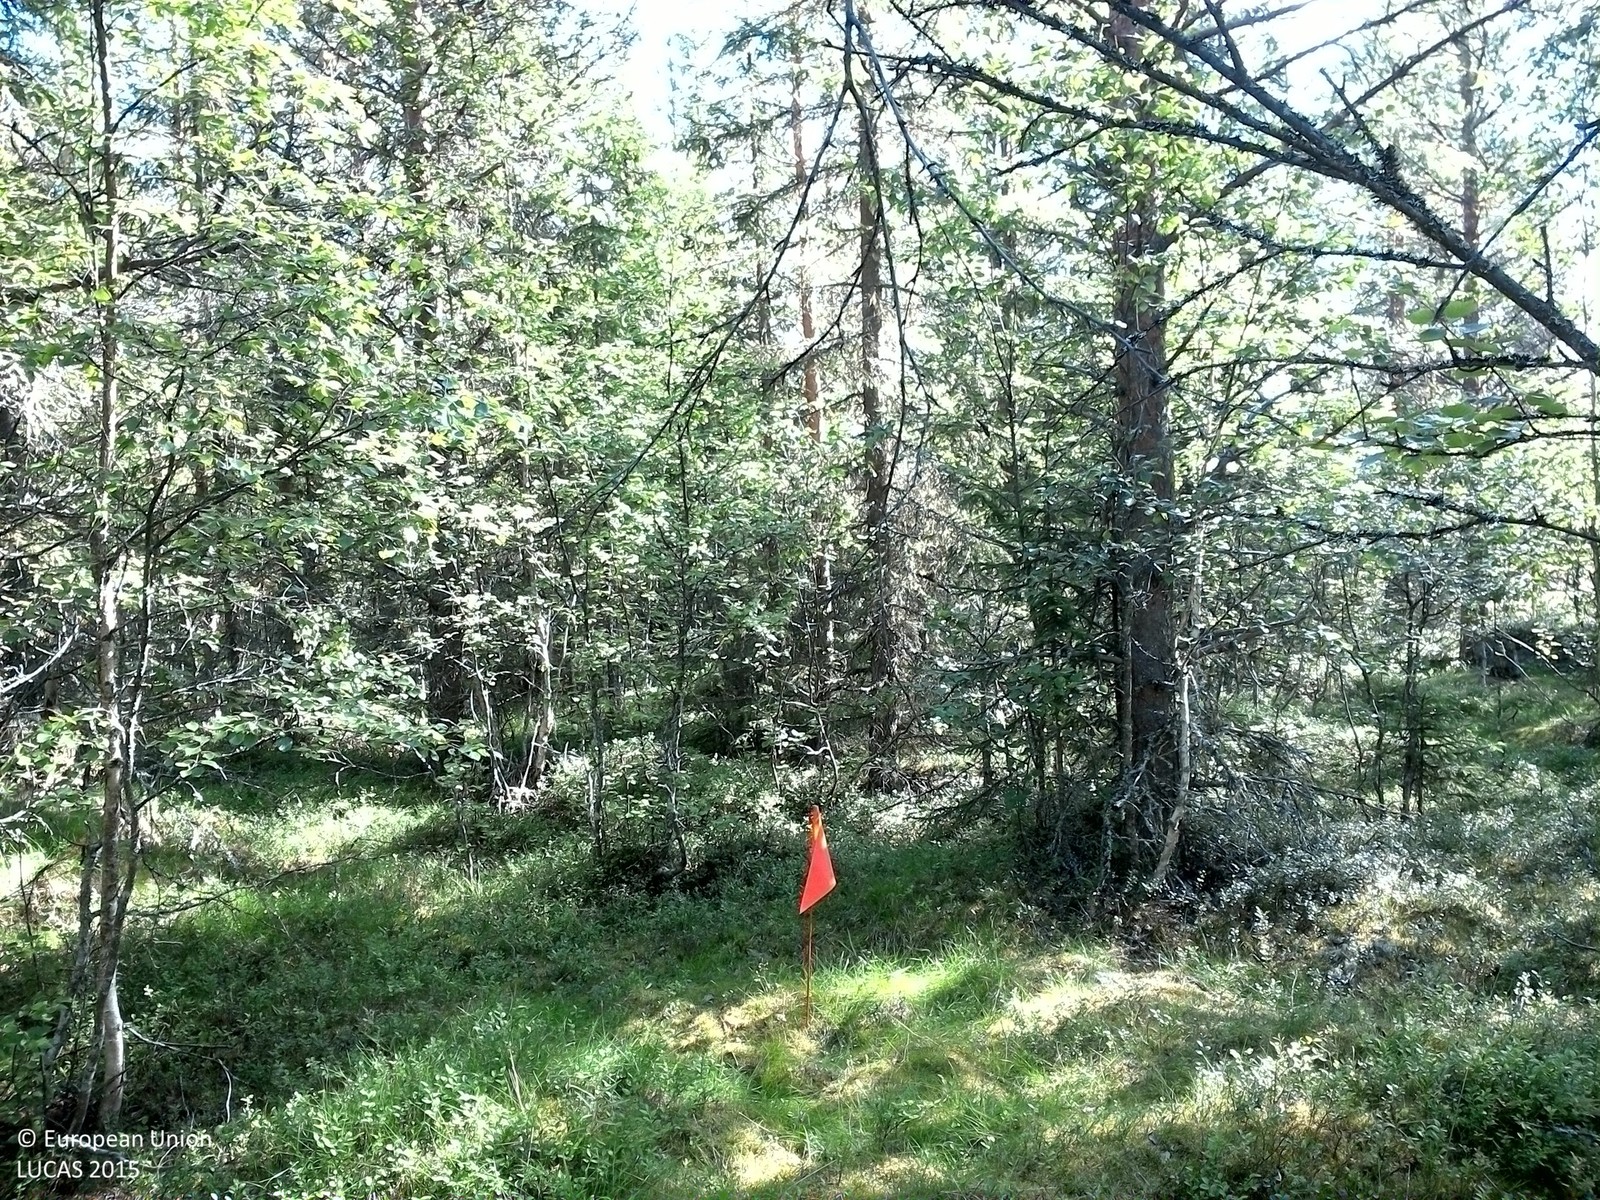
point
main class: Woodland
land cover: Pine dominated coniferous woodland
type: boreal forest
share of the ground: 50 - 75 %
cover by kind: coniferous forest trees 65 %, broadleaved forest trees 10 %, shrubs 10 %, lichens and mosses 10 %, herbaceous plants 5 %
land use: Forestry
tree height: > 5 m
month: August
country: SE
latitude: 63.7235
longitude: 18.0109
